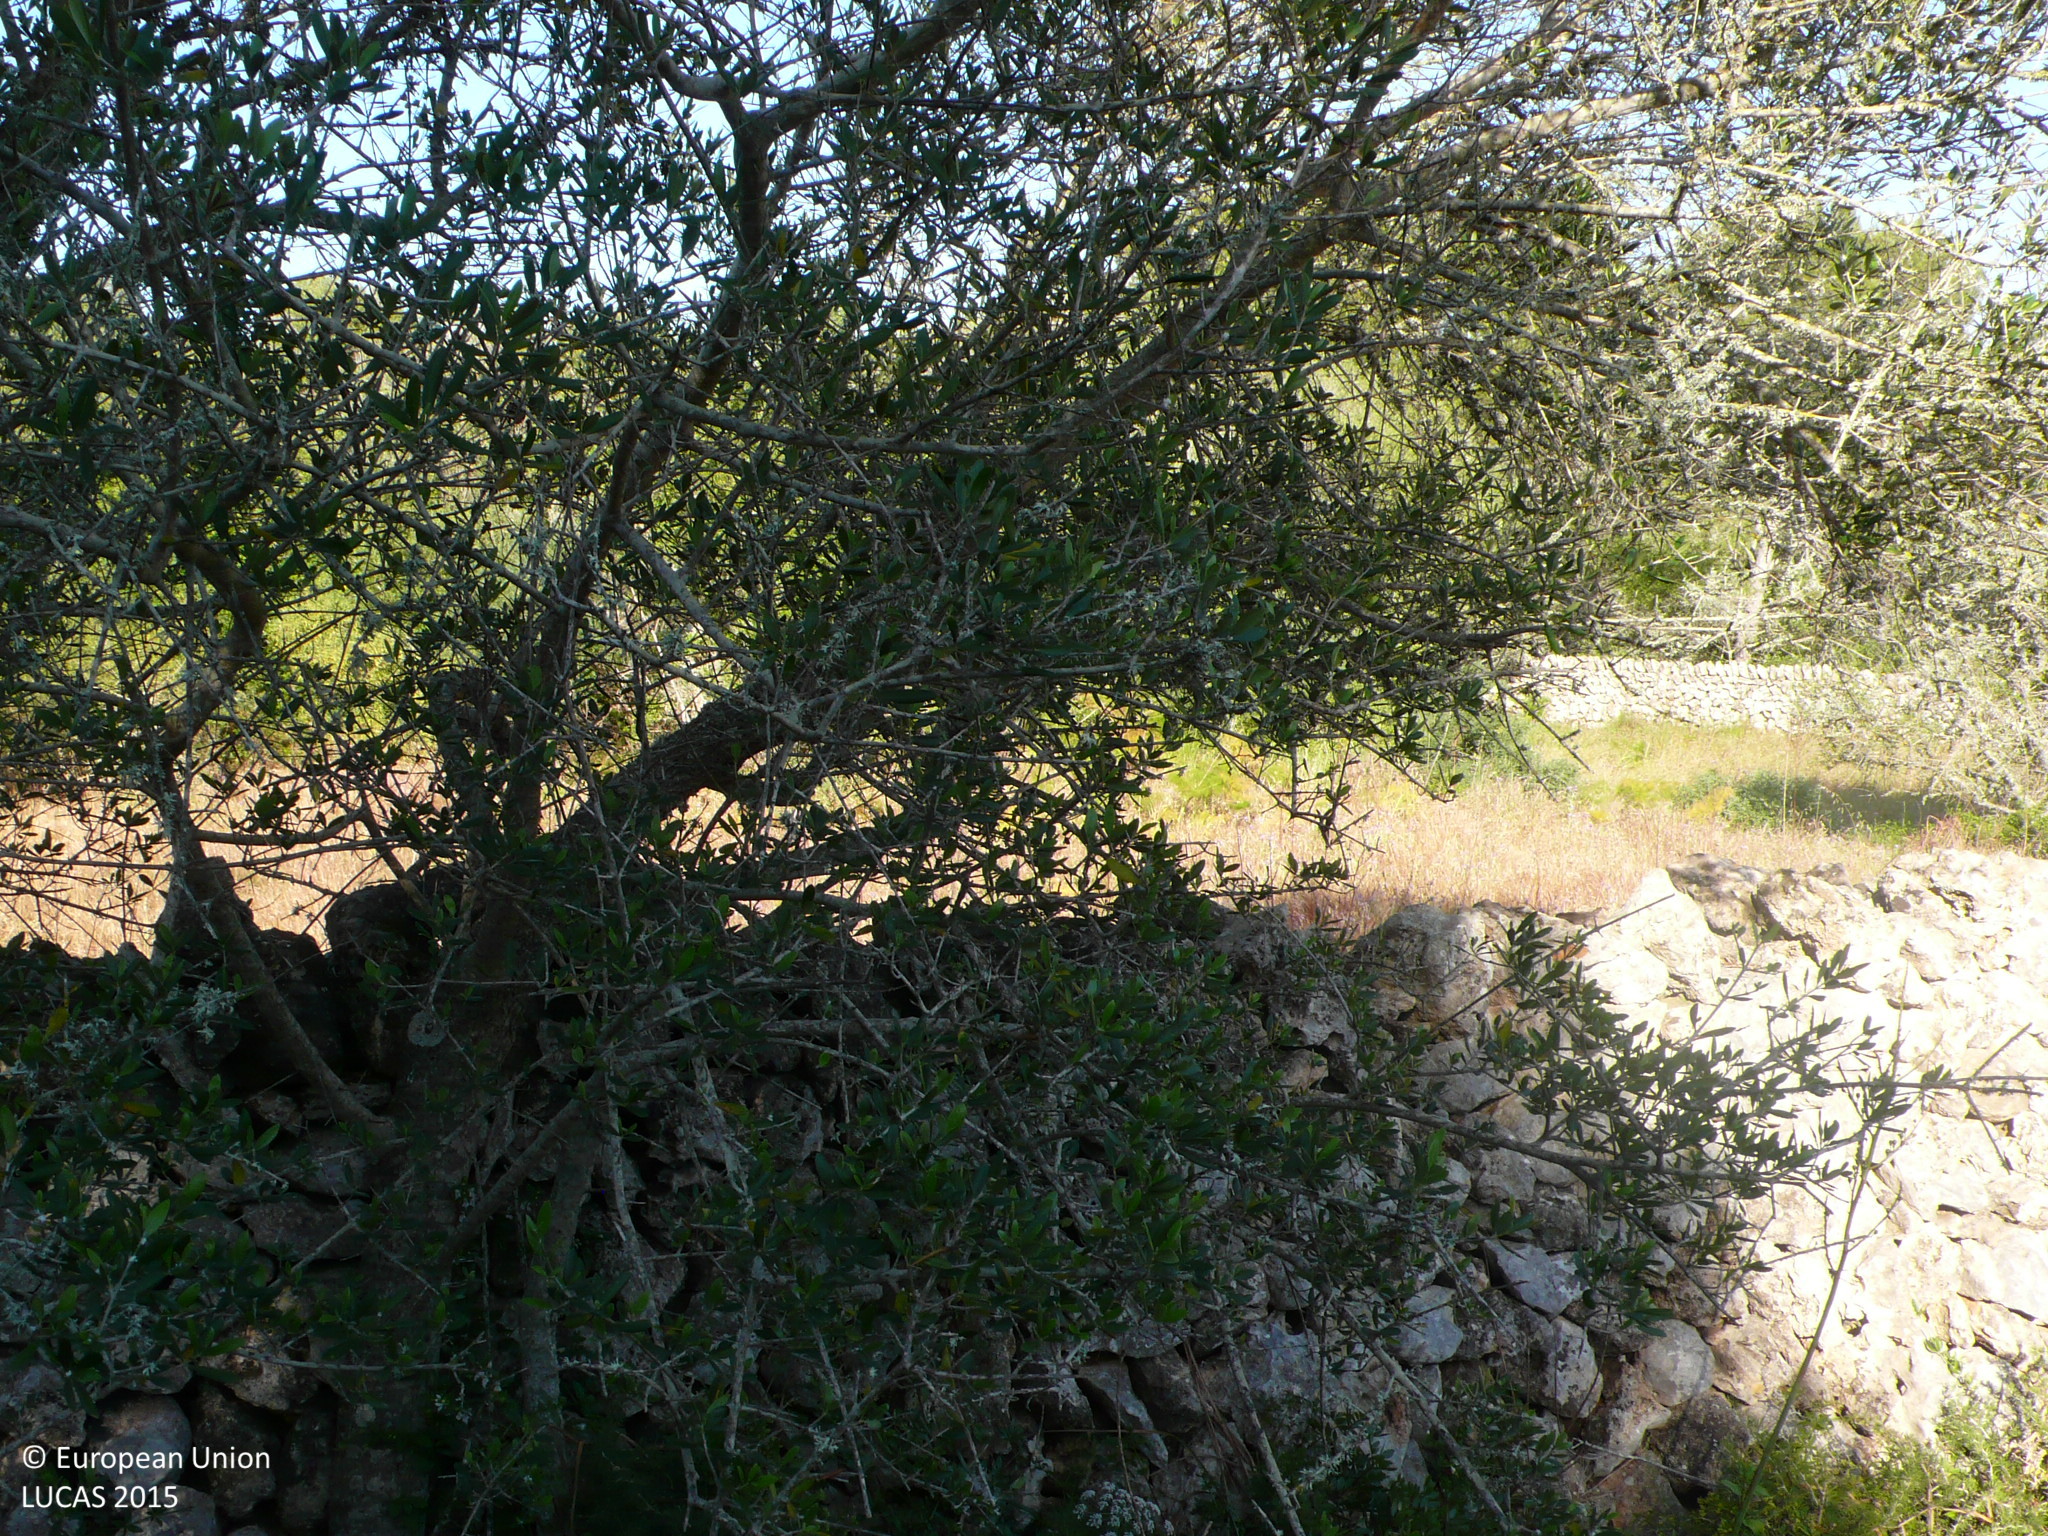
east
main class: Woodland
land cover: Broadleaved woodland
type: broadleaved evergreen forest
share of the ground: 25 - 50 %
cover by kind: herbaceous plants 40 %, shrubs 30 %, broadleaved forest trees 25 %, consolidated bare surface 5 %
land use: Semi-natural and natural areas not in use
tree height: > 5 m
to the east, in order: Broadleaved woodland; Dry stone walls; Broadleaved woodland; Dry stone walls; Broadleaved woodland; Rock outcrops; Broadleaved woodland; Rivers and streams; Broadleaved woodland; Grassland with sparse tree/shrub cover; Broadleaved woodland
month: May
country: ES
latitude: 39.8747
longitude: 4.1454
